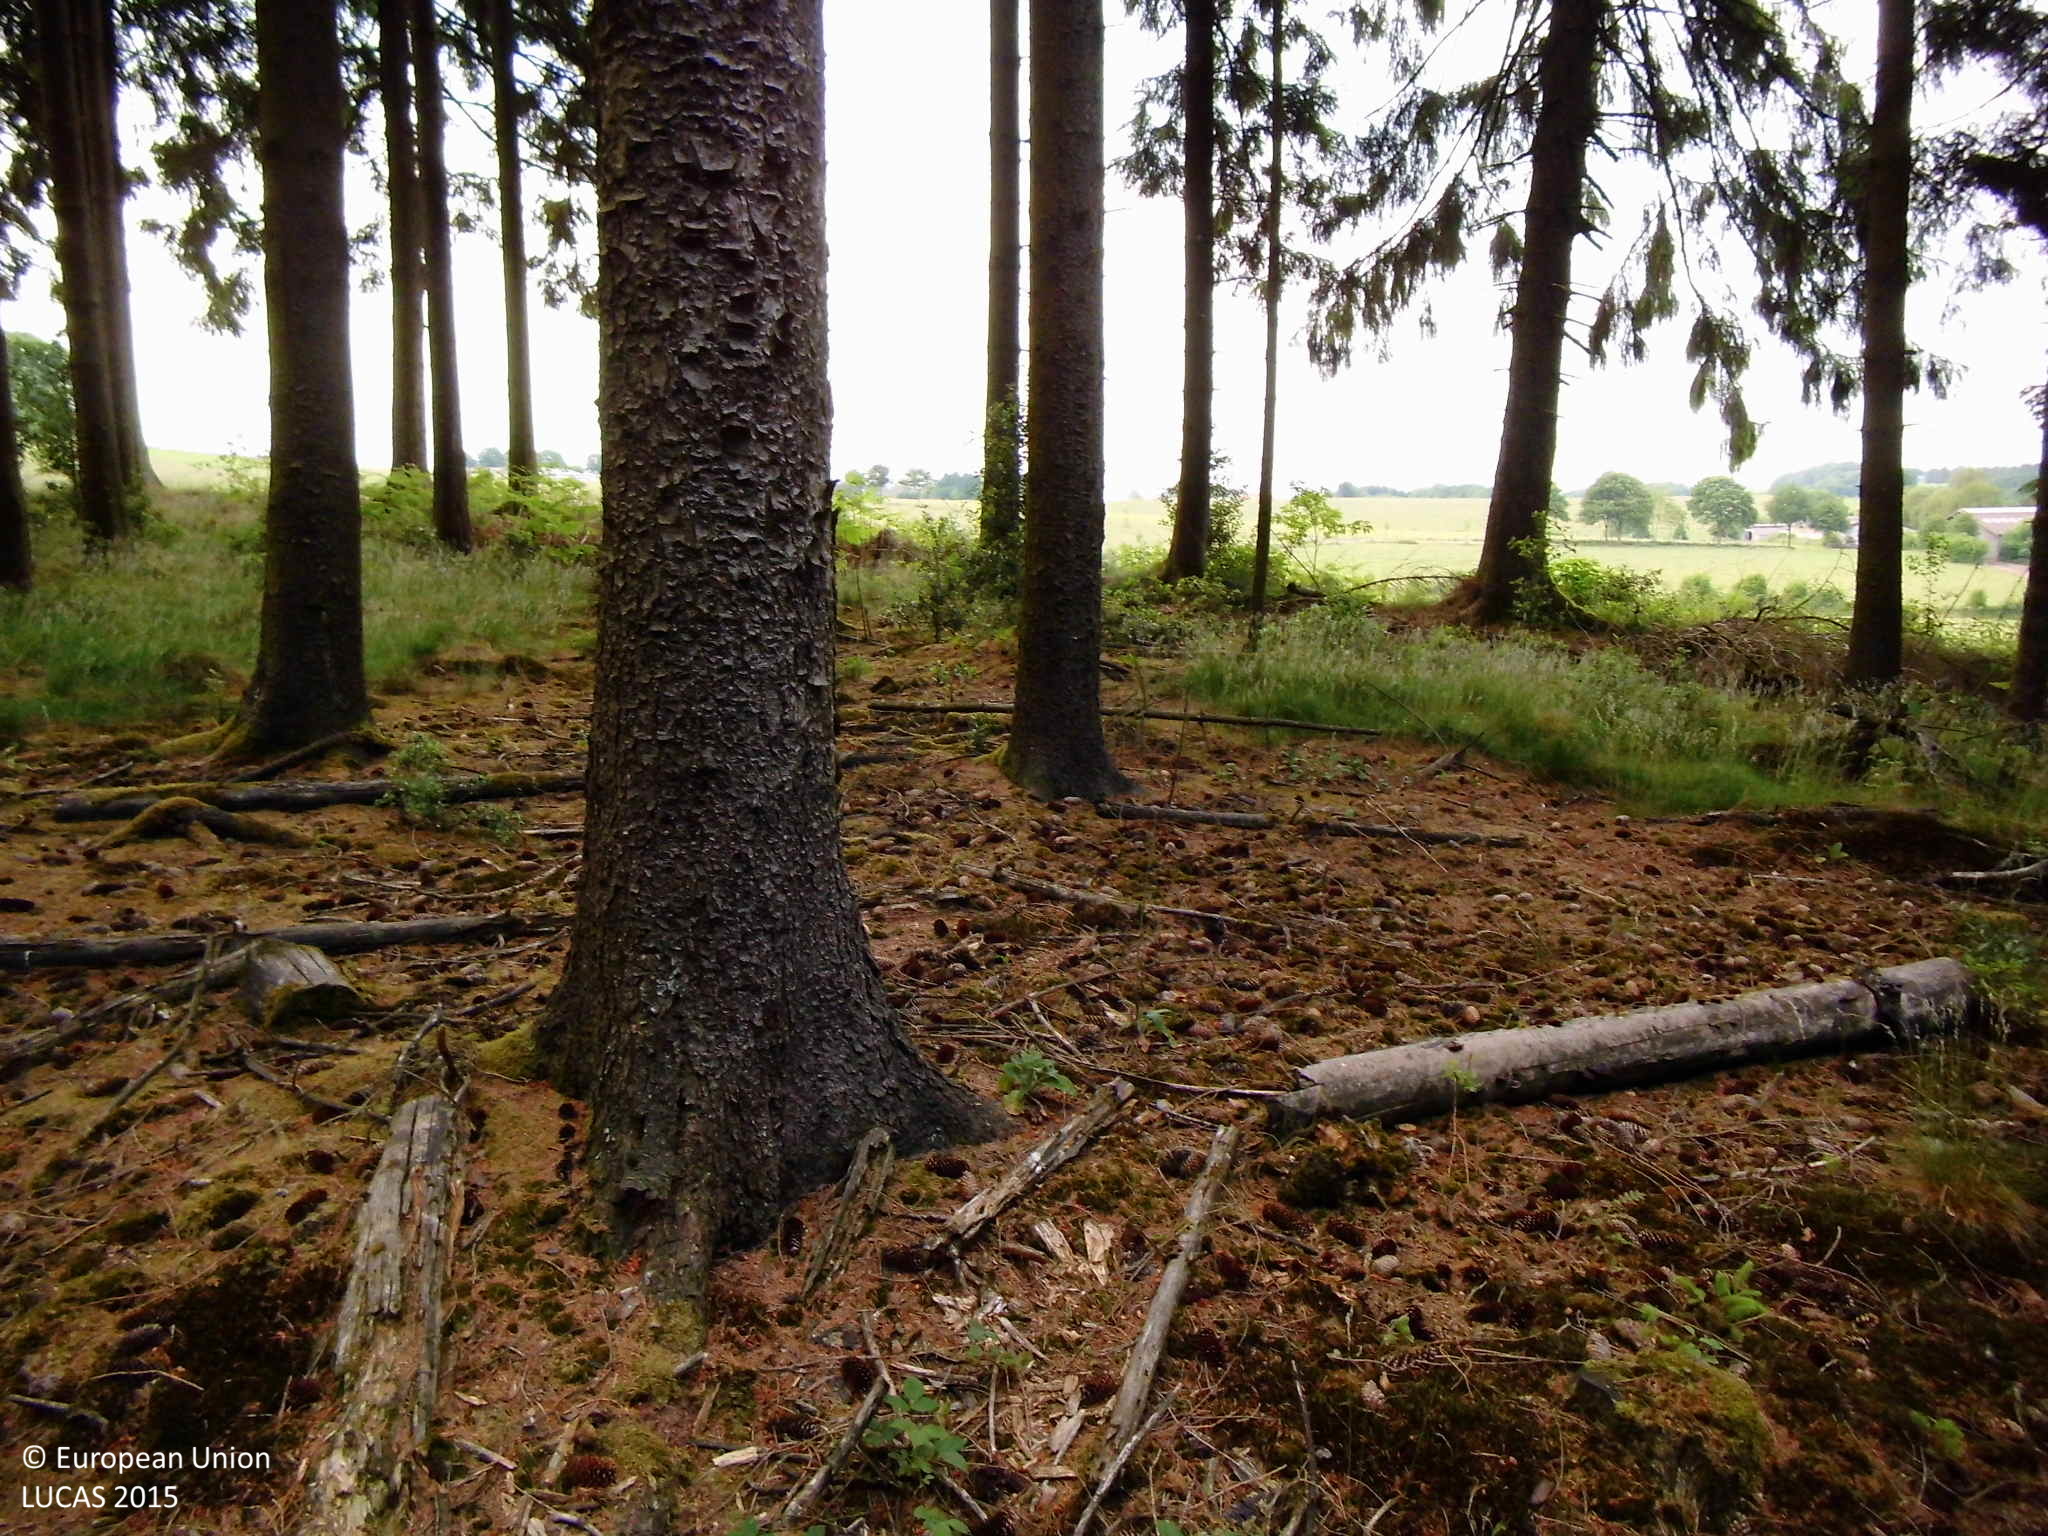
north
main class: Woodland
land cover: Spruce dominated coniferous woodland
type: hemiboreal forest and nemoral coniferous forest and mixed broadleaved-coniferous forest
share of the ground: 25 - 50 %
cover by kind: coniferous forest trees 45 %, lichens and mosses 20 %, shrubs 15 %, herbaceous plants 15 %, unconsolidated bare surface 5 %
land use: Forestry
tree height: > 5 m
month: June
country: DE
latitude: 51.2180
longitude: 7.4947
